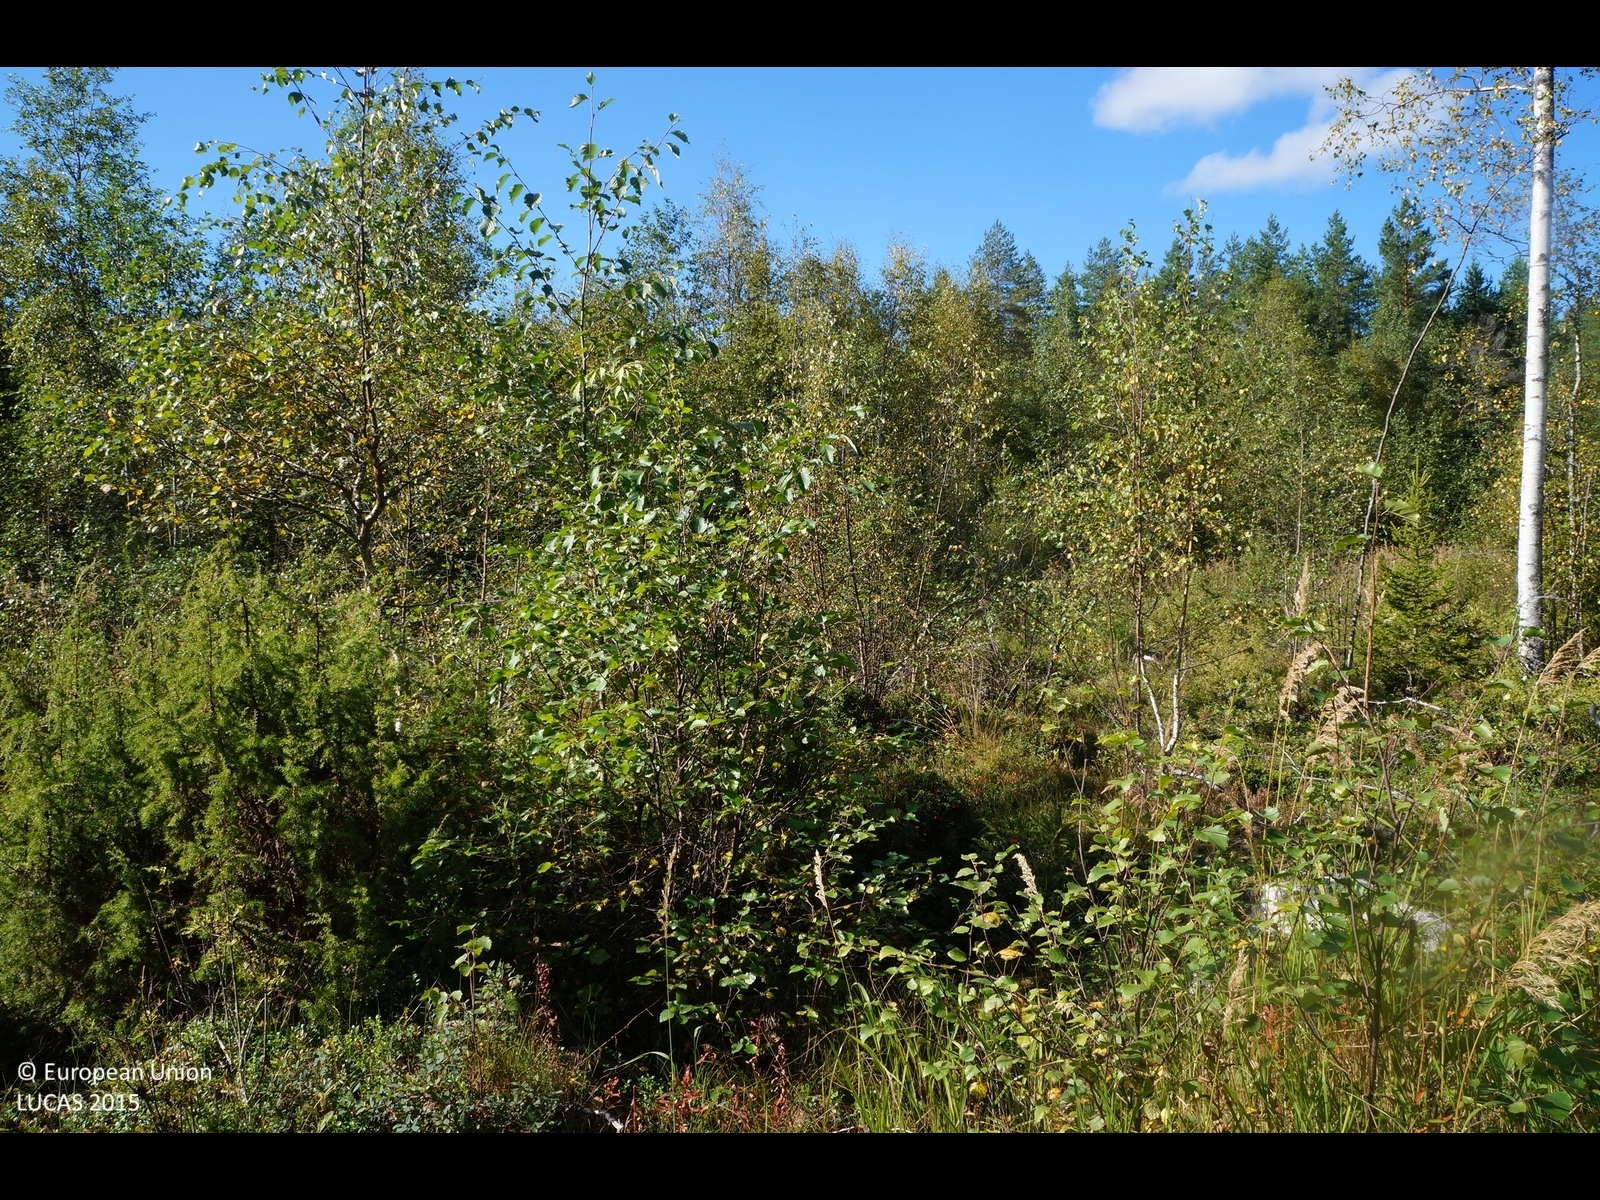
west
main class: Woodland
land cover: Broadleaved woodland
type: boreal forest
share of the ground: 25 - 50 %
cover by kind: shrubs 60 %, broadleaved forest trees 25 %, lichens and mosses 10 %, herbaceous plants 5 %
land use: Forestry
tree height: < 5 m
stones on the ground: < 10 %
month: September
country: FI
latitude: 63.9629
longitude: 24.3448
